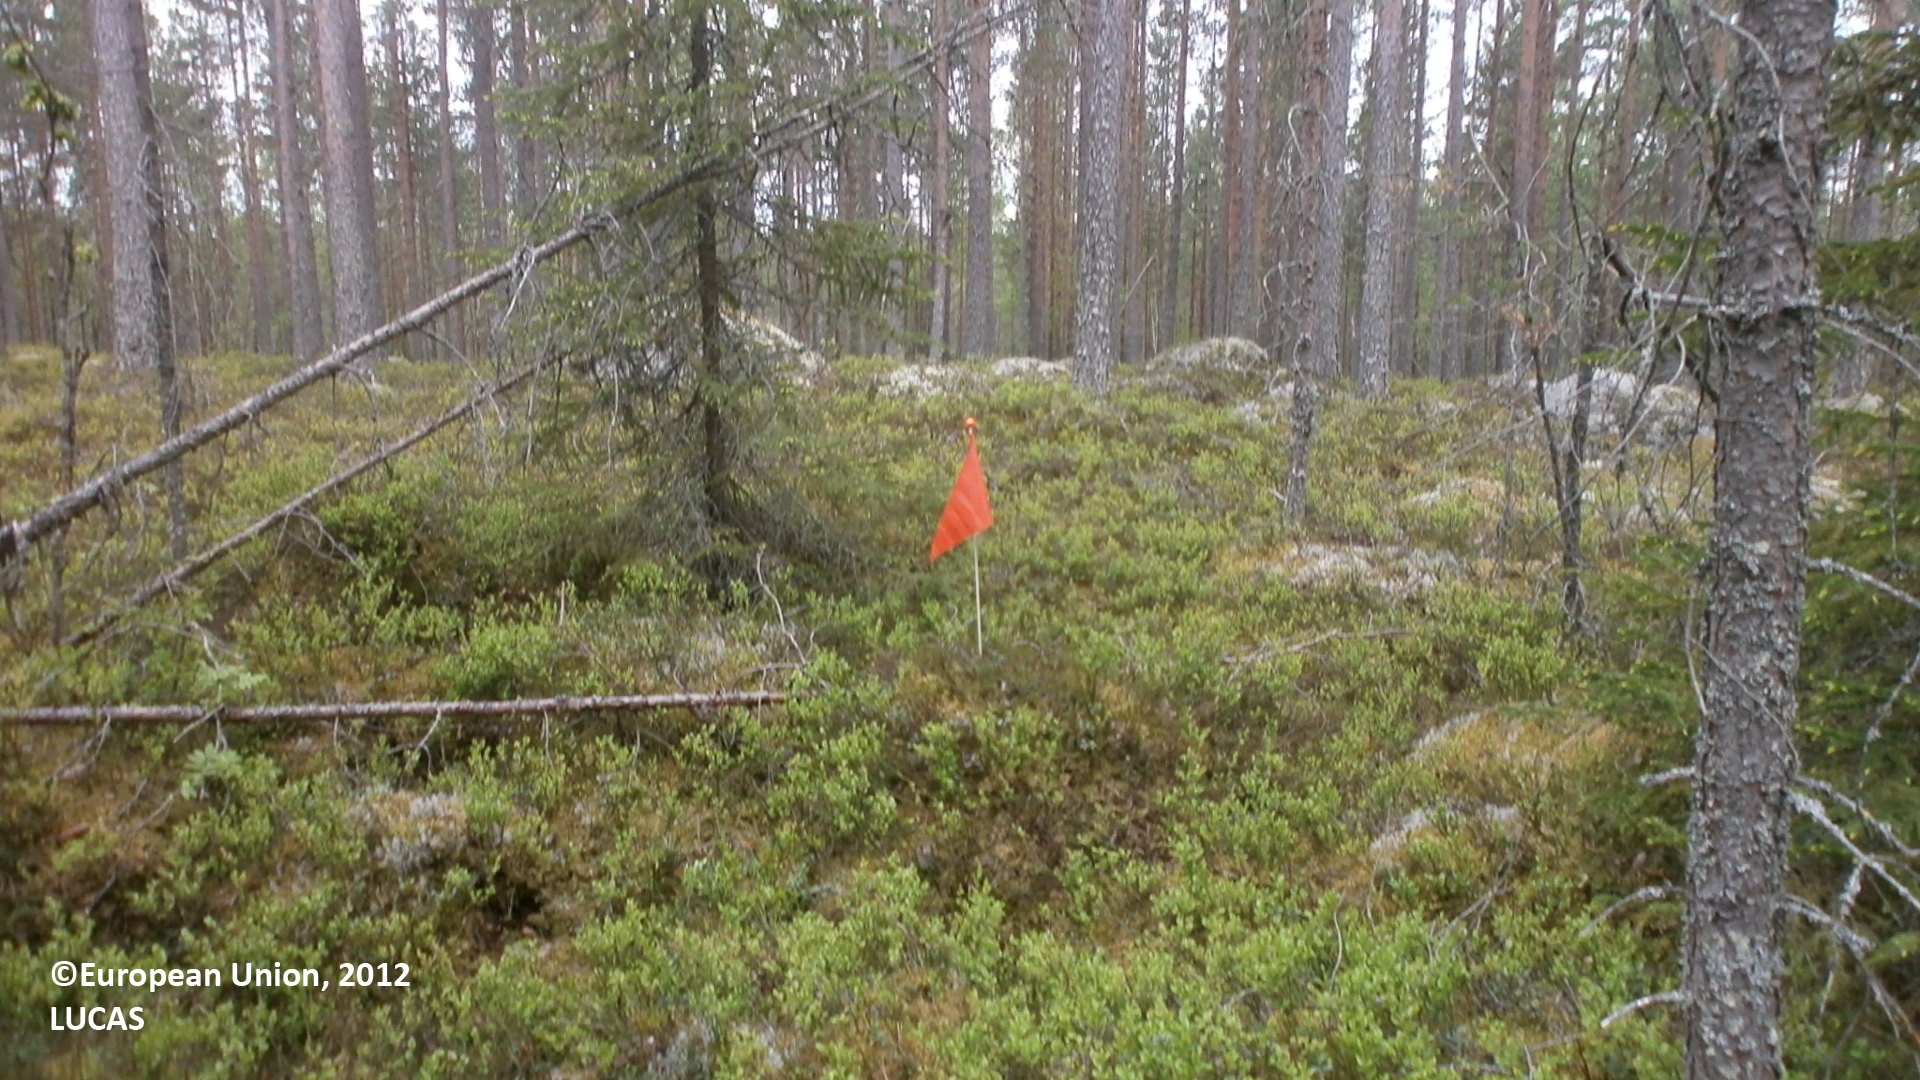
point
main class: Woodland
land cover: Pine dominated coniferous woodland
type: hemiboreal forest and nemoral coniferous forest and mixed broadleaved-coniferous forest
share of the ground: 25 - 50 %
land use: Forestry
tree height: > 5 m
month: June
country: FI
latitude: 64.4410
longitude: 25.1437
